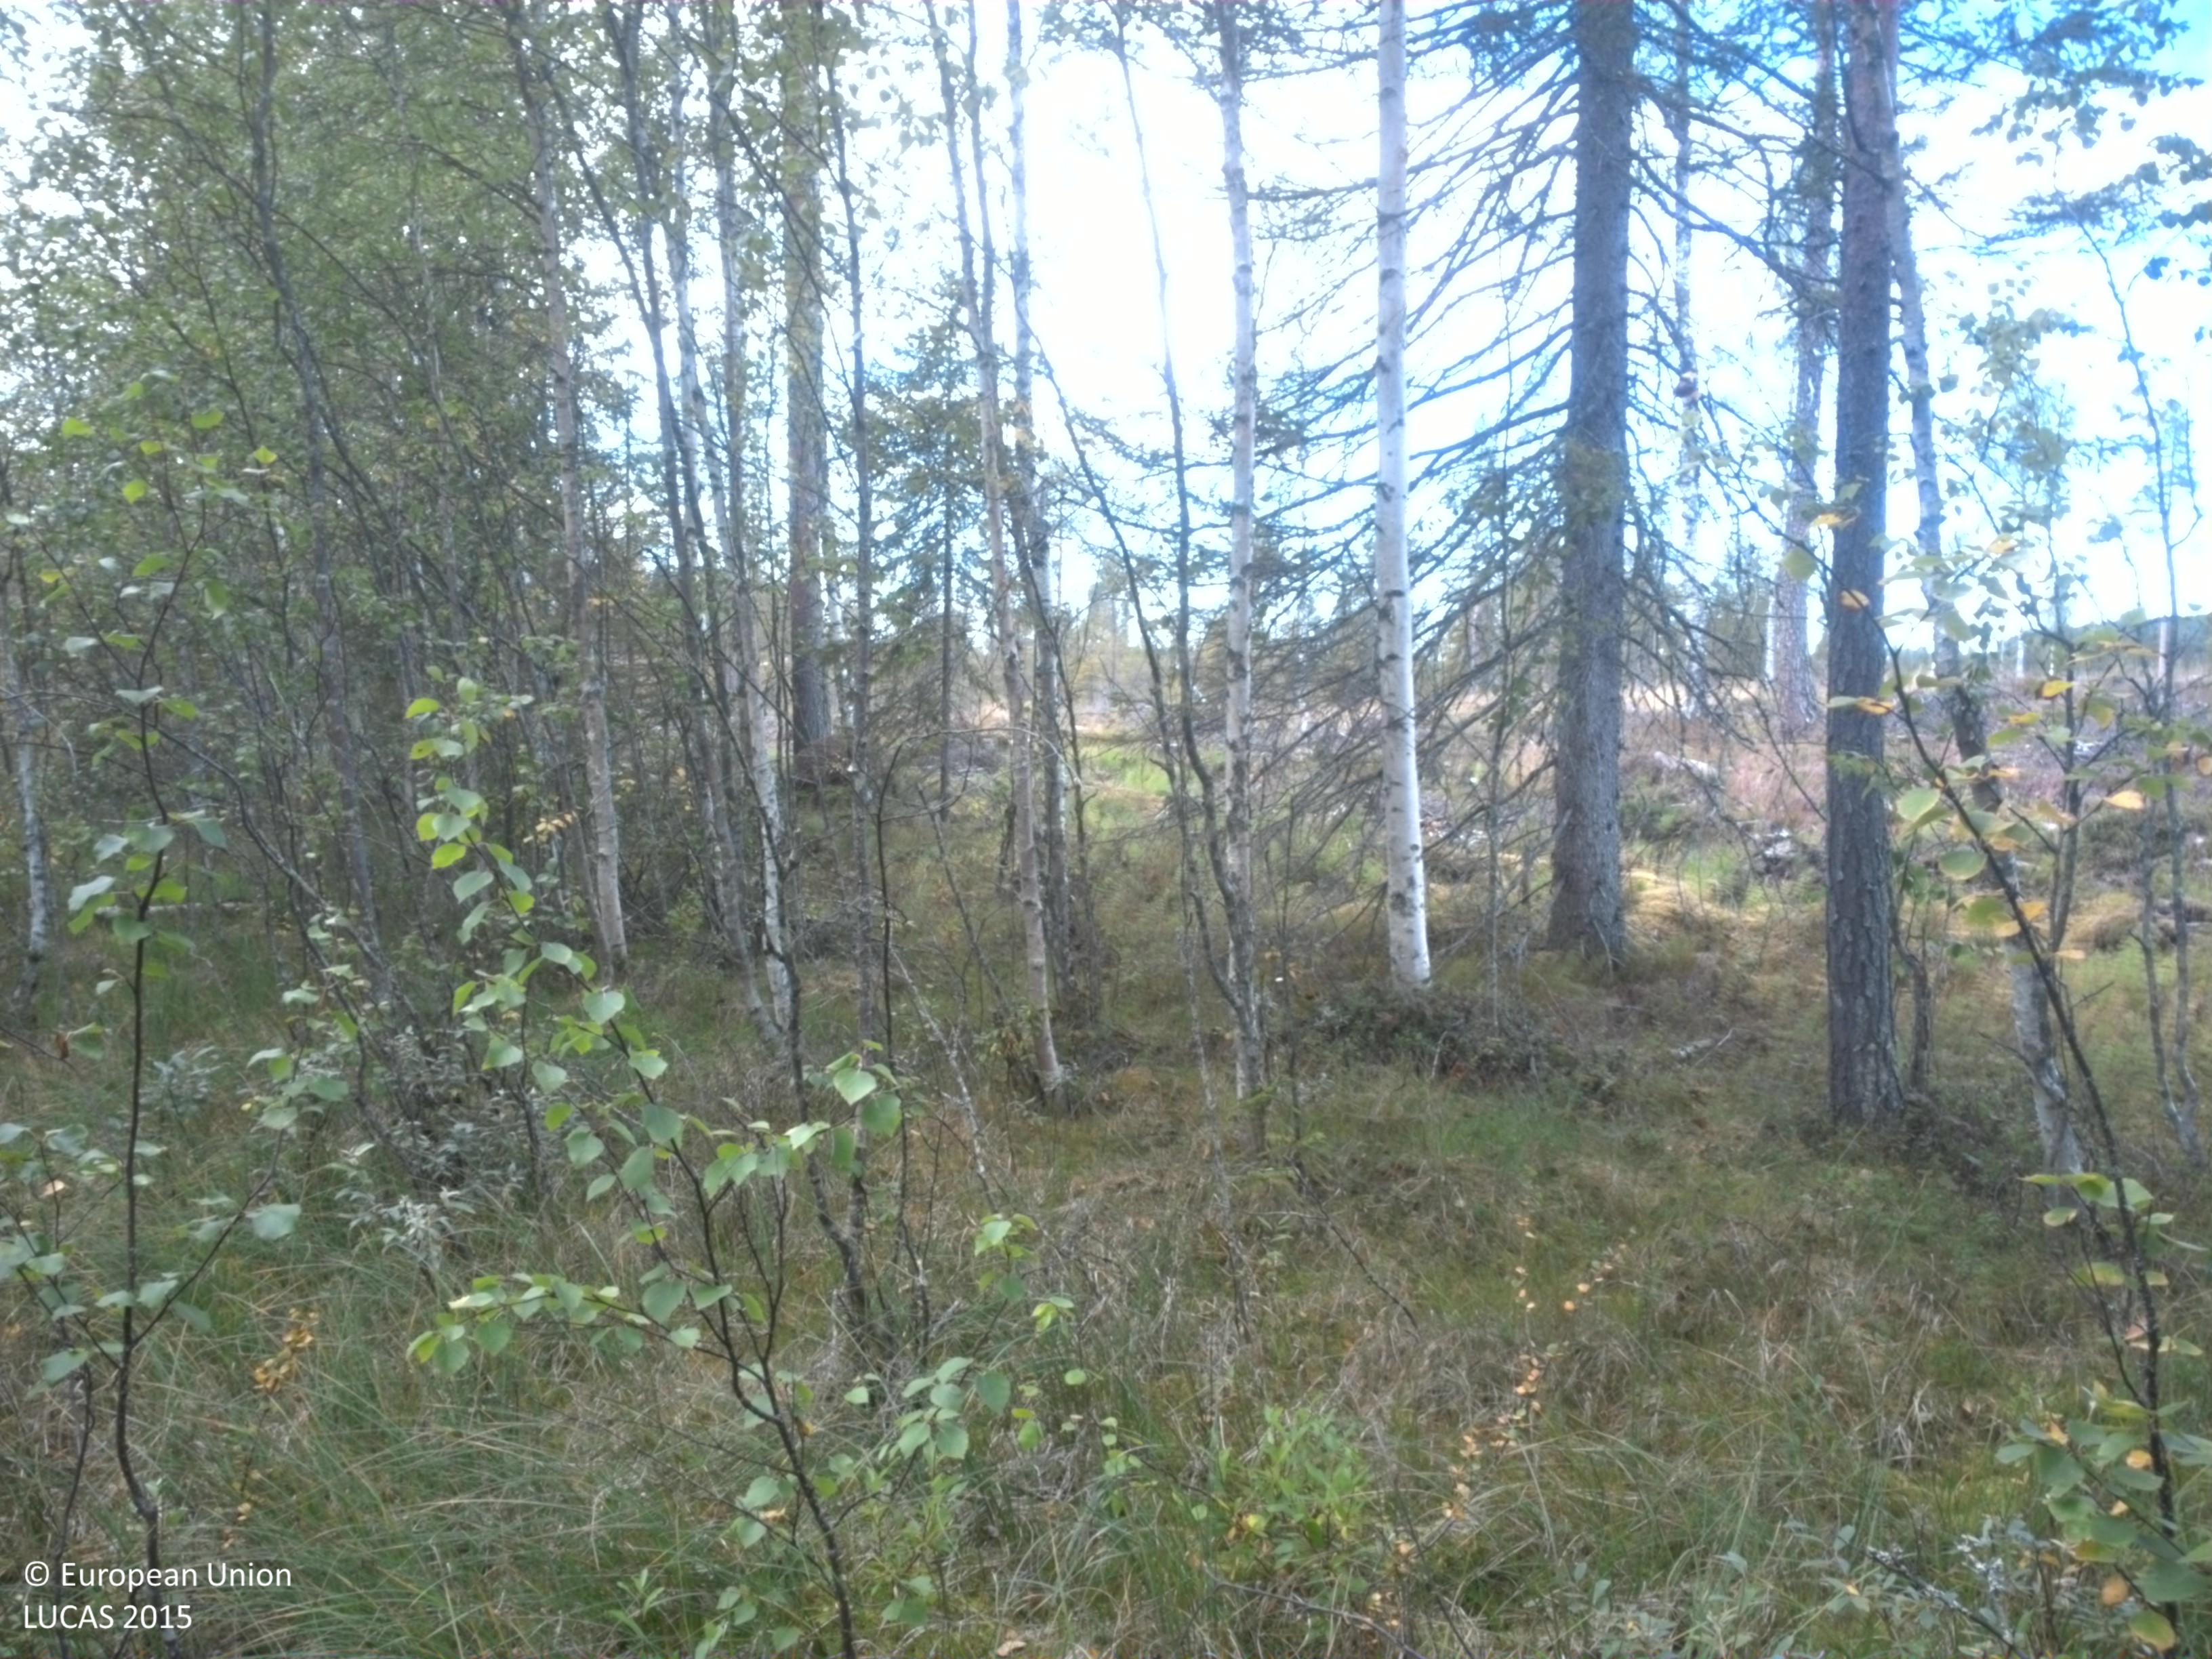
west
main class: Woodland
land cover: Other mixed woodland
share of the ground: 50 - 75 %
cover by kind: coniferous forest trees 25 %, broadleaved forest trees 25 %, herbaceous plants 20 %, lichens and mosses 20 %, shrubs 10 %
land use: Forestry
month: September
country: SE
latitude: 64.5682
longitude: 19.8024
